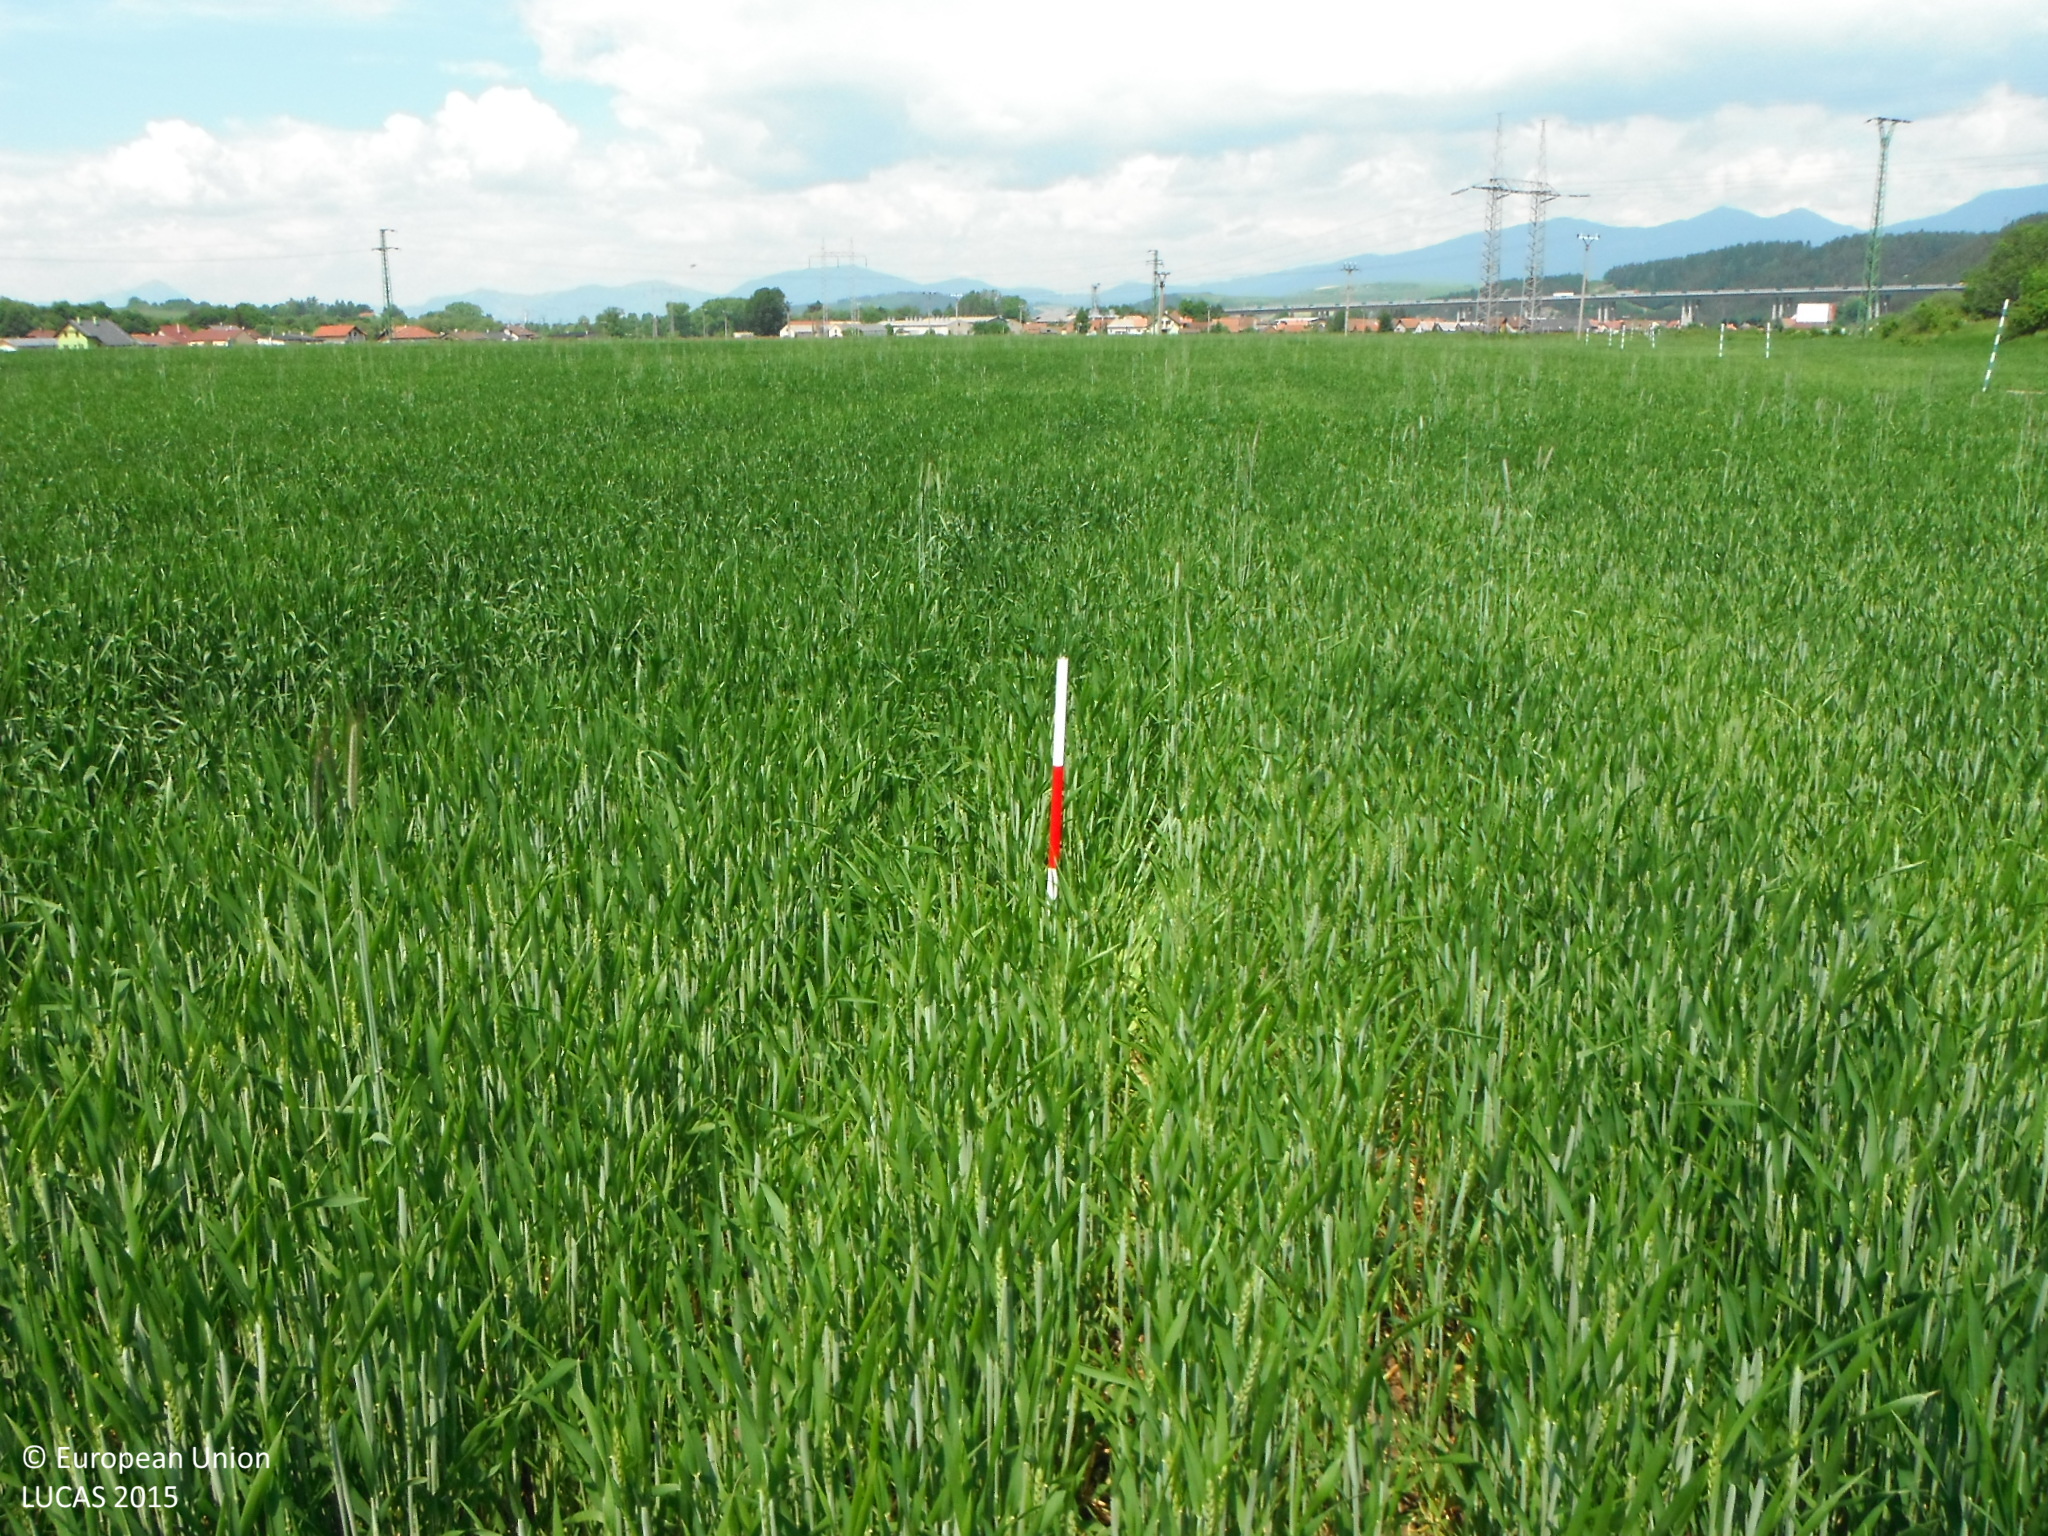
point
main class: Cropland
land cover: Common wheat
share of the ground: > 75 %
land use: Agriculture (excluding fallow land and kitchen gardens)
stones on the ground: > 50 %
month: June
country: SK
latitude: 49.0451
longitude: 19.7005
